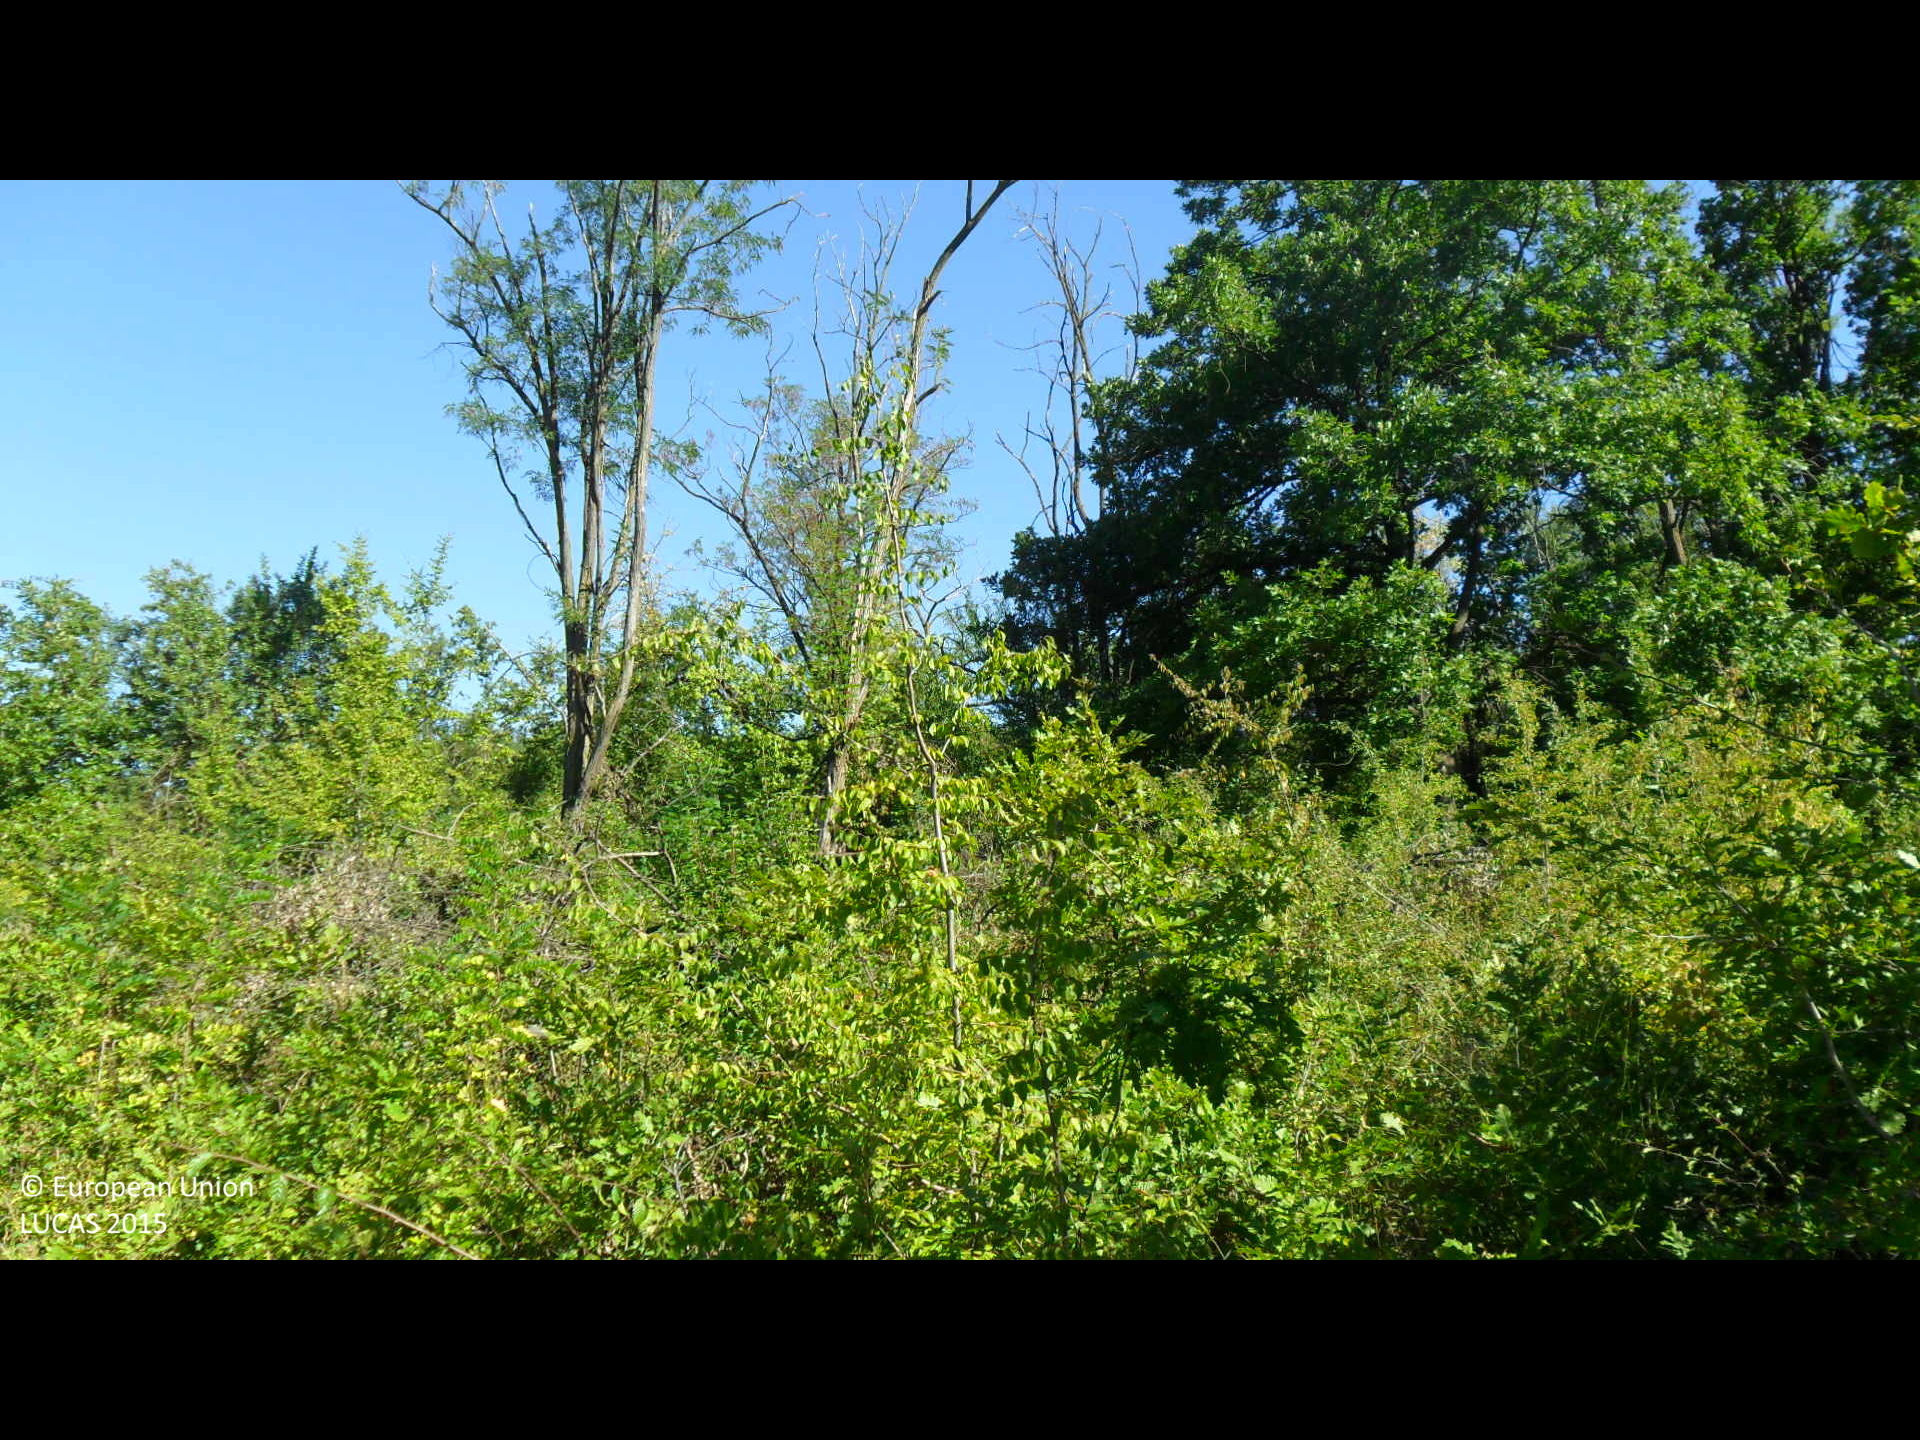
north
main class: Woodland
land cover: Broadleaved woodland
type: thermophilous deciduous forest
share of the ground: > 75 %
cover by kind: broadleaved forest trees 95 %, unconsolidated bare surface 5 %
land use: Forestry
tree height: > 5 m
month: September
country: BG
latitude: 43.1625
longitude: 26.2937
